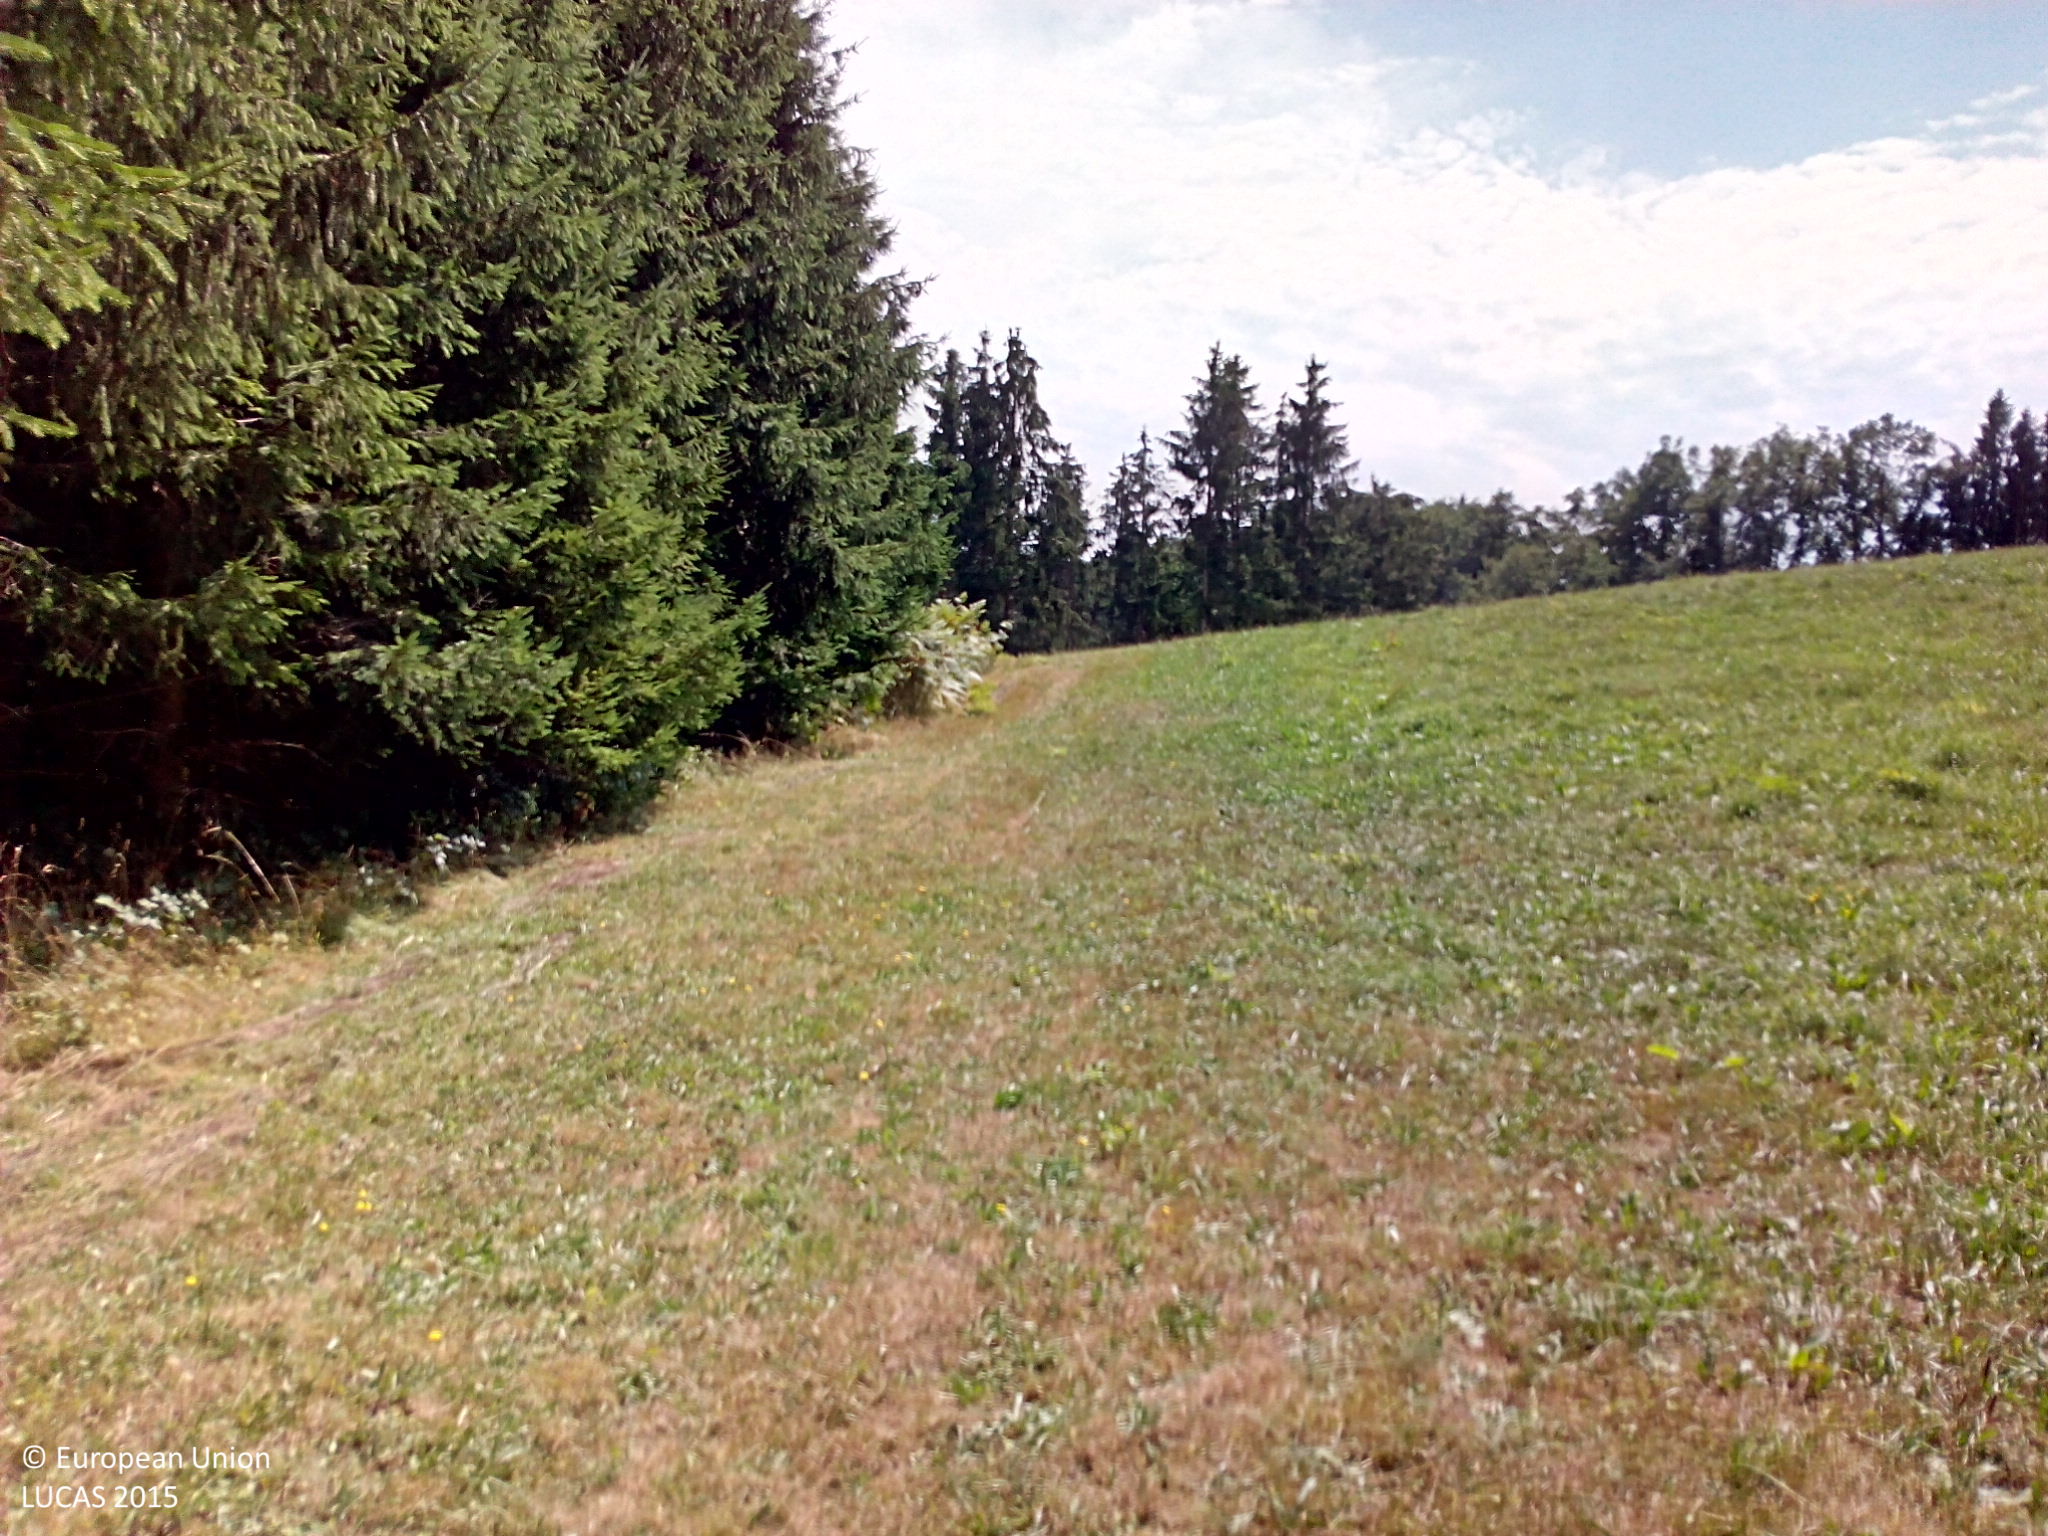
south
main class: Grassland
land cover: Grassland without tree/shrub cover
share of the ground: > 75 %
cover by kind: herbaceous plants 100 %
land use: Agriculture (excluding fallow land and kitchen gardens)
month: August
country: DE
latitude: 47.6495
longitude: 8.1242
